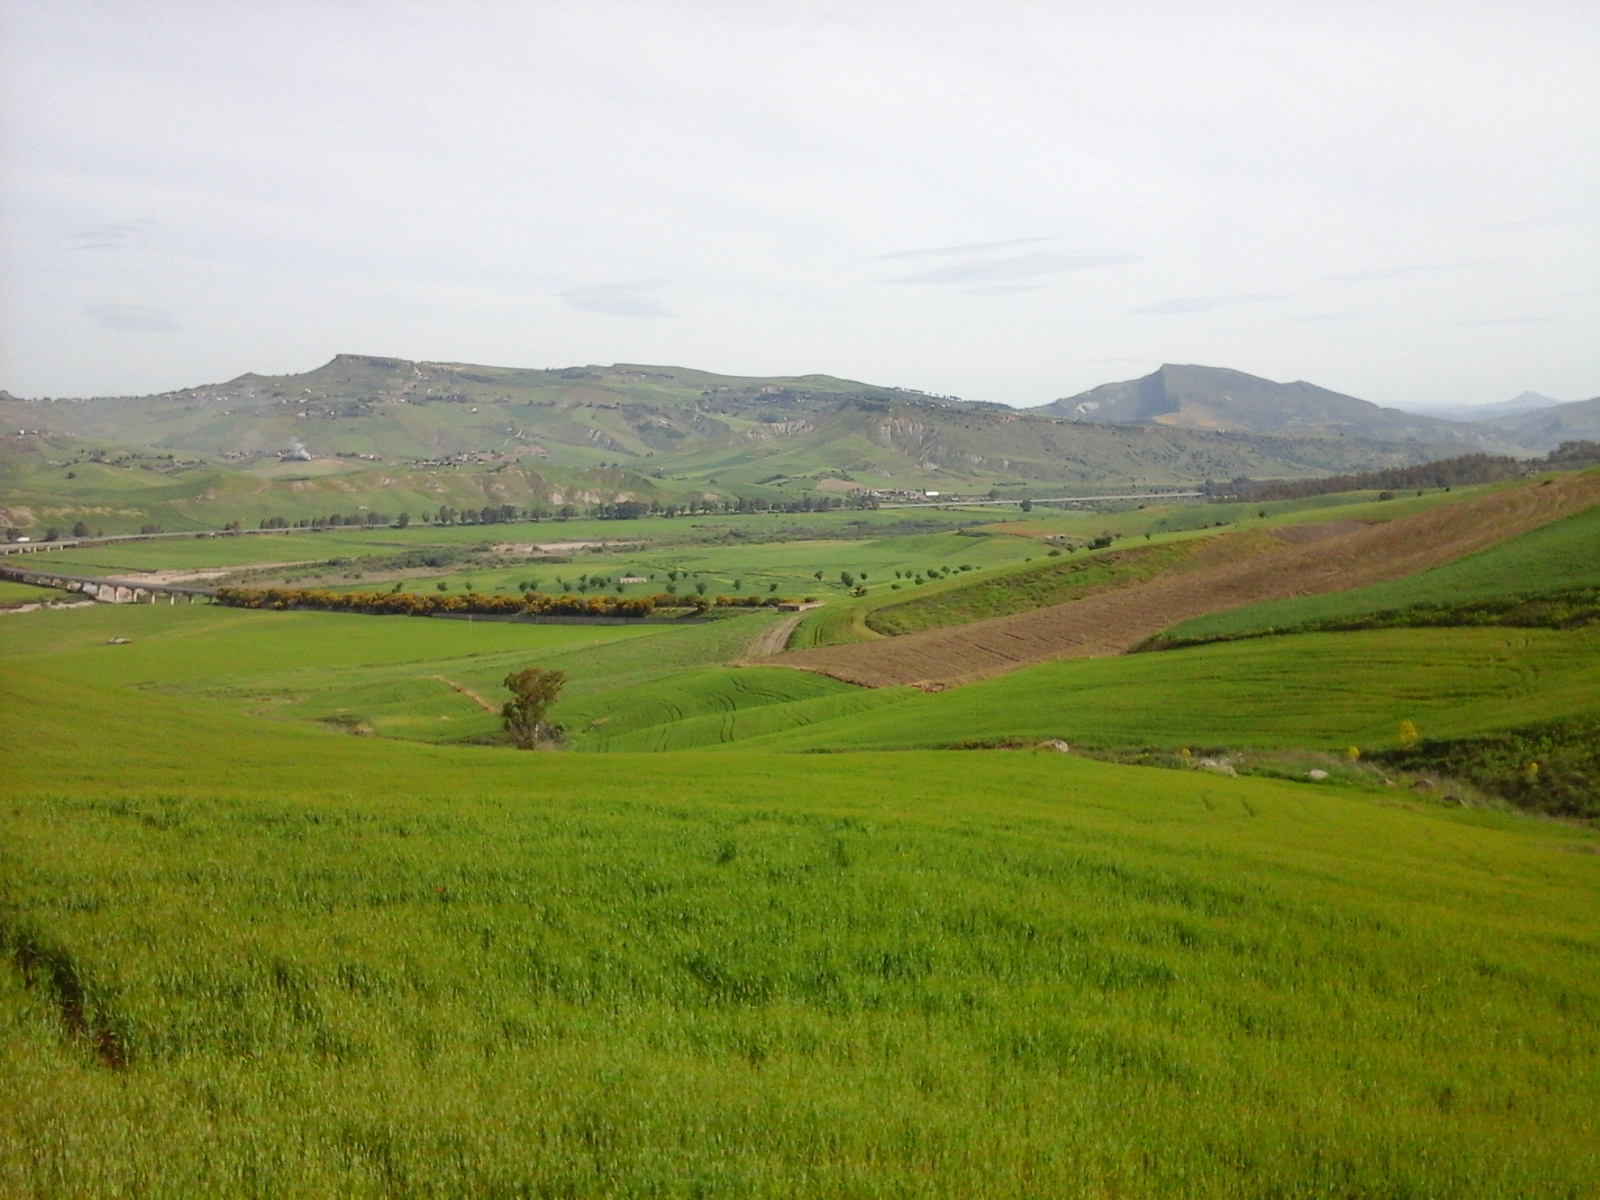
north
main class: Cropland
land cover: Other leguminous and mixtures for fodder
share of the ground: > 75 %
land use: Agriculture (excluding fallow land and kitchen gardens)
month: May
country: IT
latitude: 37.4403
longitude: 14.1170
